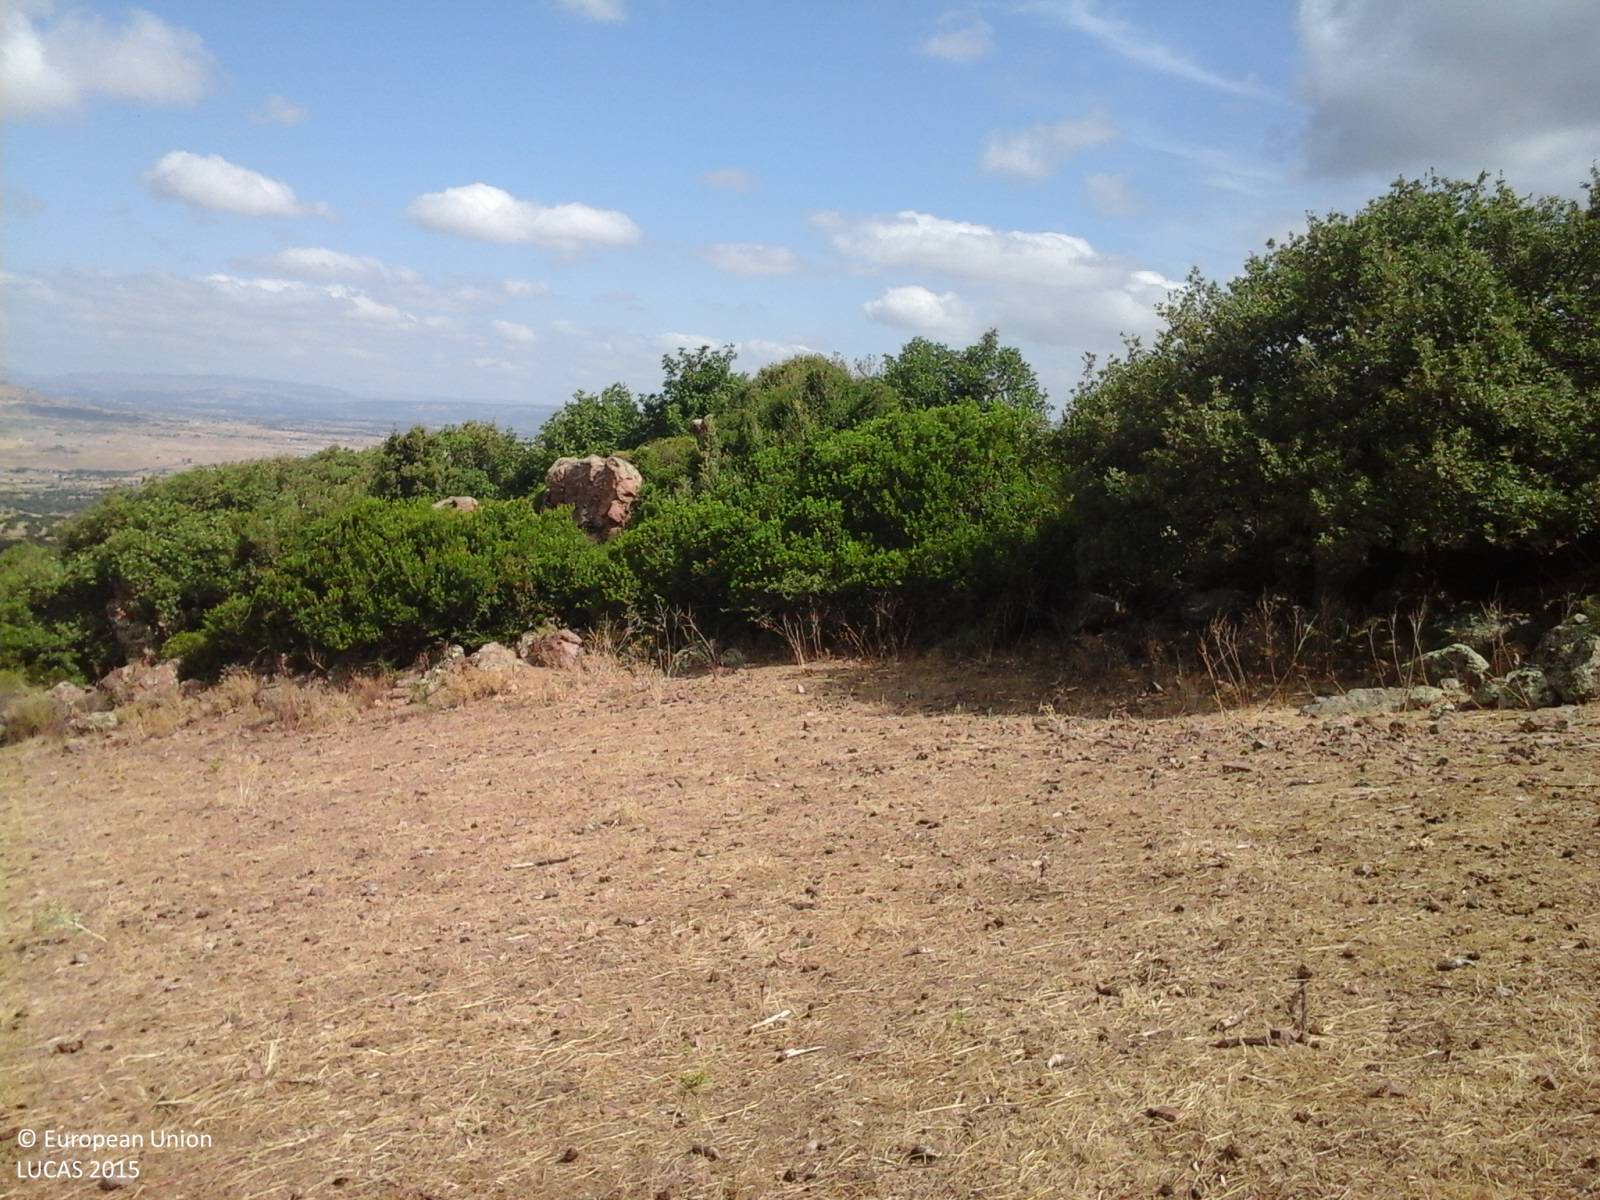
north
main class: Grassland
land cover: Grassland without tree/shrub cover
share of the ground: < 10 %
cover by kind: herbaceous plants 100 %
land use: Agriculture (excluding fallow land and kitchen gardens)
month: July
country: IT
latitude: 40.4966
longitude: 8.9082
